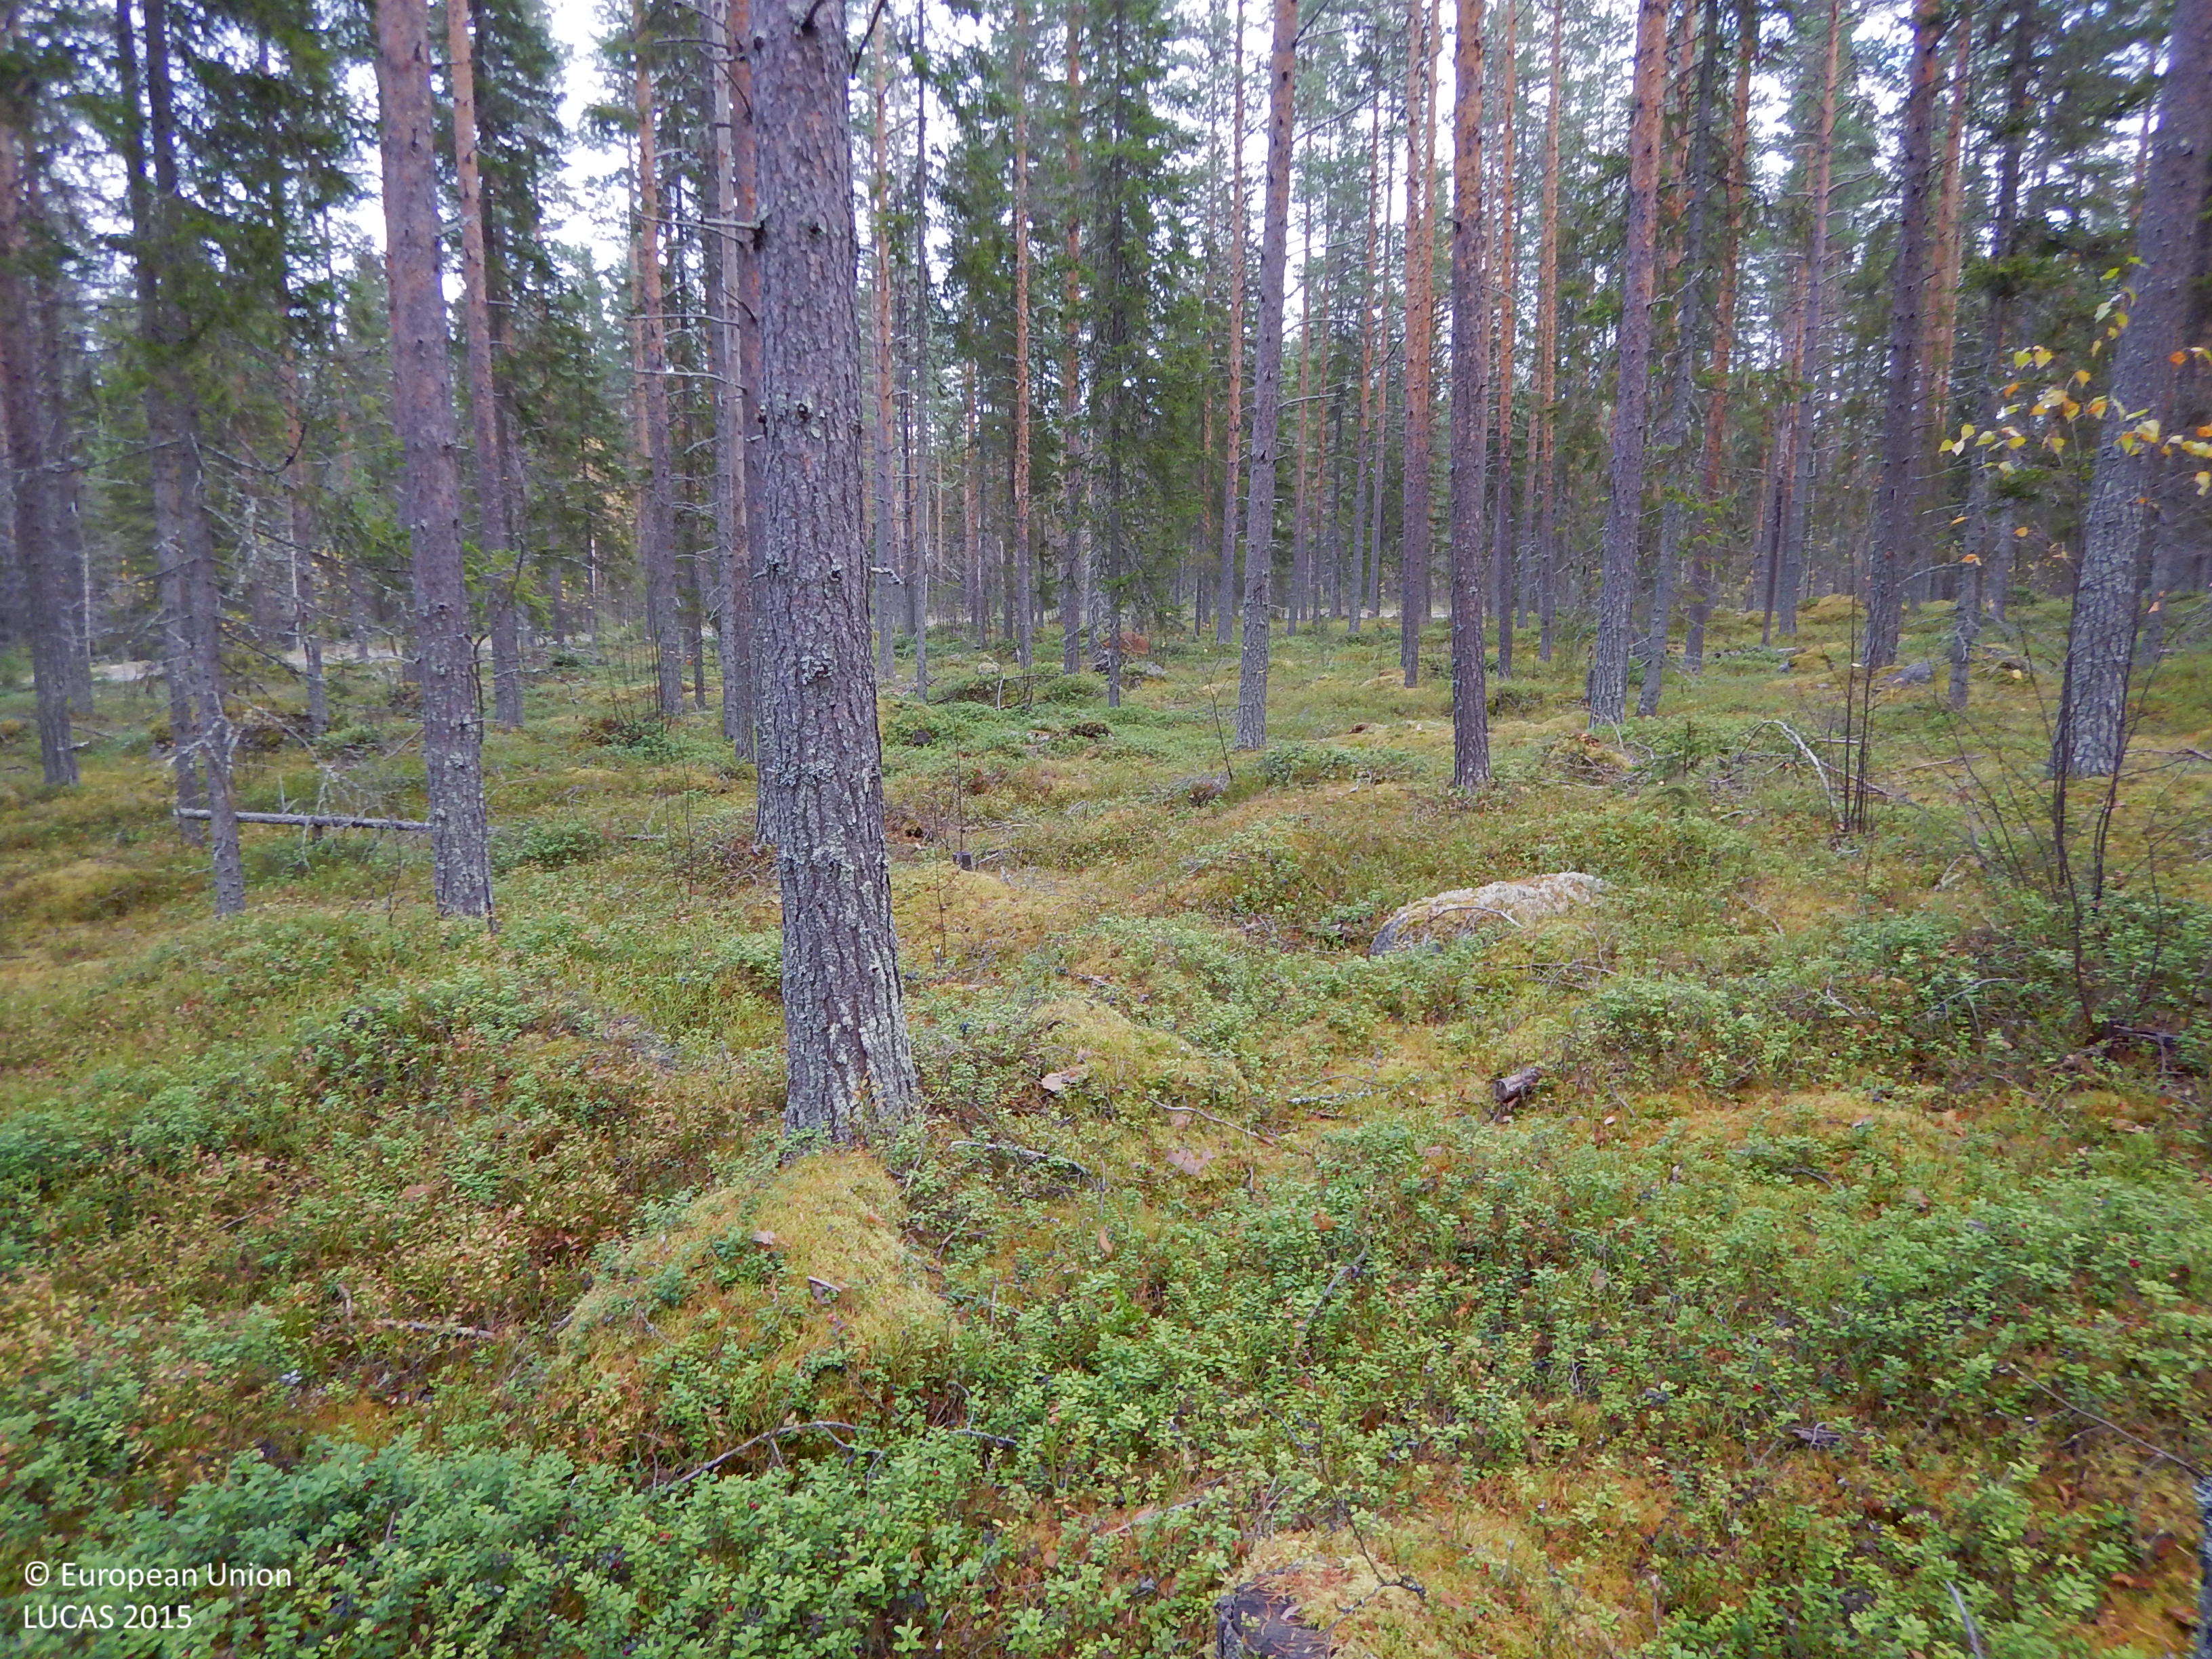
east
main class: Woodland
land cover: Pine dominated coniferous woodland
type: boreal forest
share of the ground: 50 - 75 %
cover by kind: coniferous forest trees 60 %, shrubs 20 %, lichens and mosses 10 %, broadleaved forest trees 5 %, herbaceous plants 5 %
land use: Forestry
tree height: > 5 m
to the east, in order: Pine dominated coniferous woodland; Other coniferous woodland; Ditches and canals; Grass margins; Paved roads, cycling and walking lanes; Grass margins; Other coniferous woodland; Pine dominated coniferous woodland
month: October
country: SE
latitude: 65.1217
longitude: 21.1171
